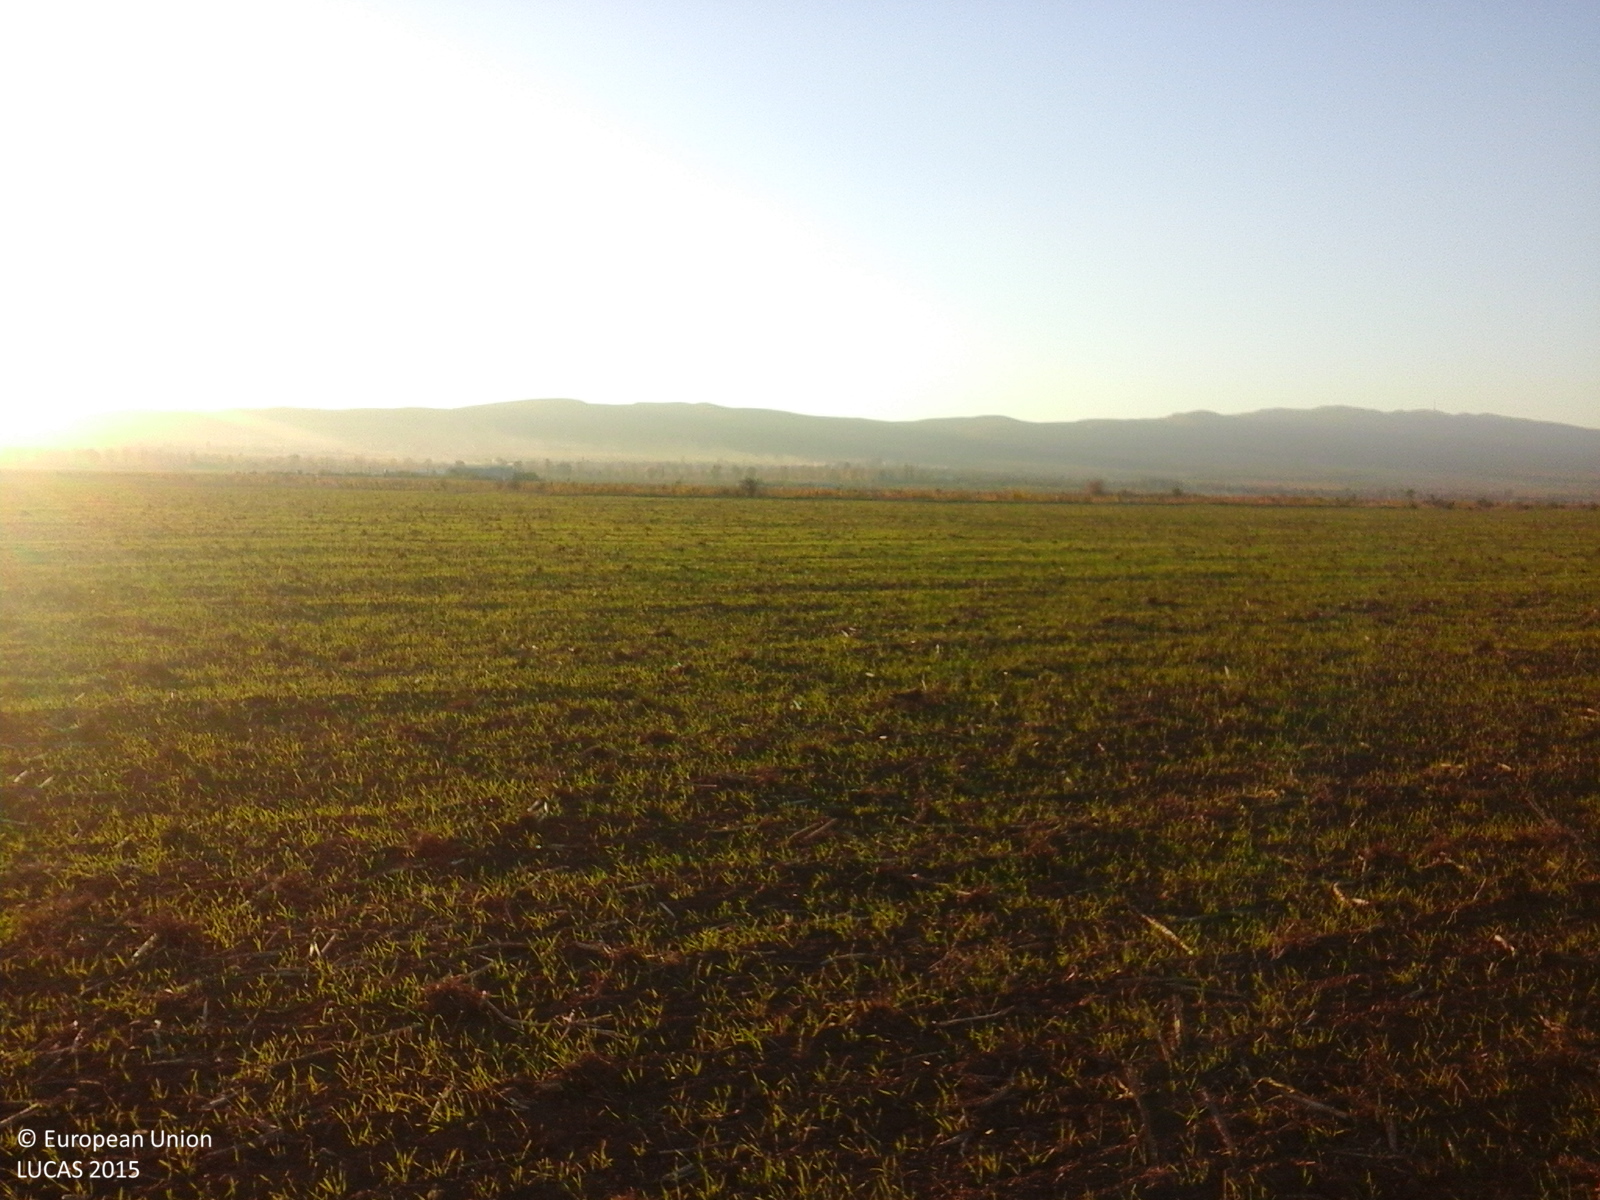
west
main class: Cropland
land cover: Common wheat
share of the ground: 10 - 25 %
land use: Agriculture (excluding fallow land and kitchen gardens)
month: October
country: RO
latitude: 45.7869
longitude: 27.1114
